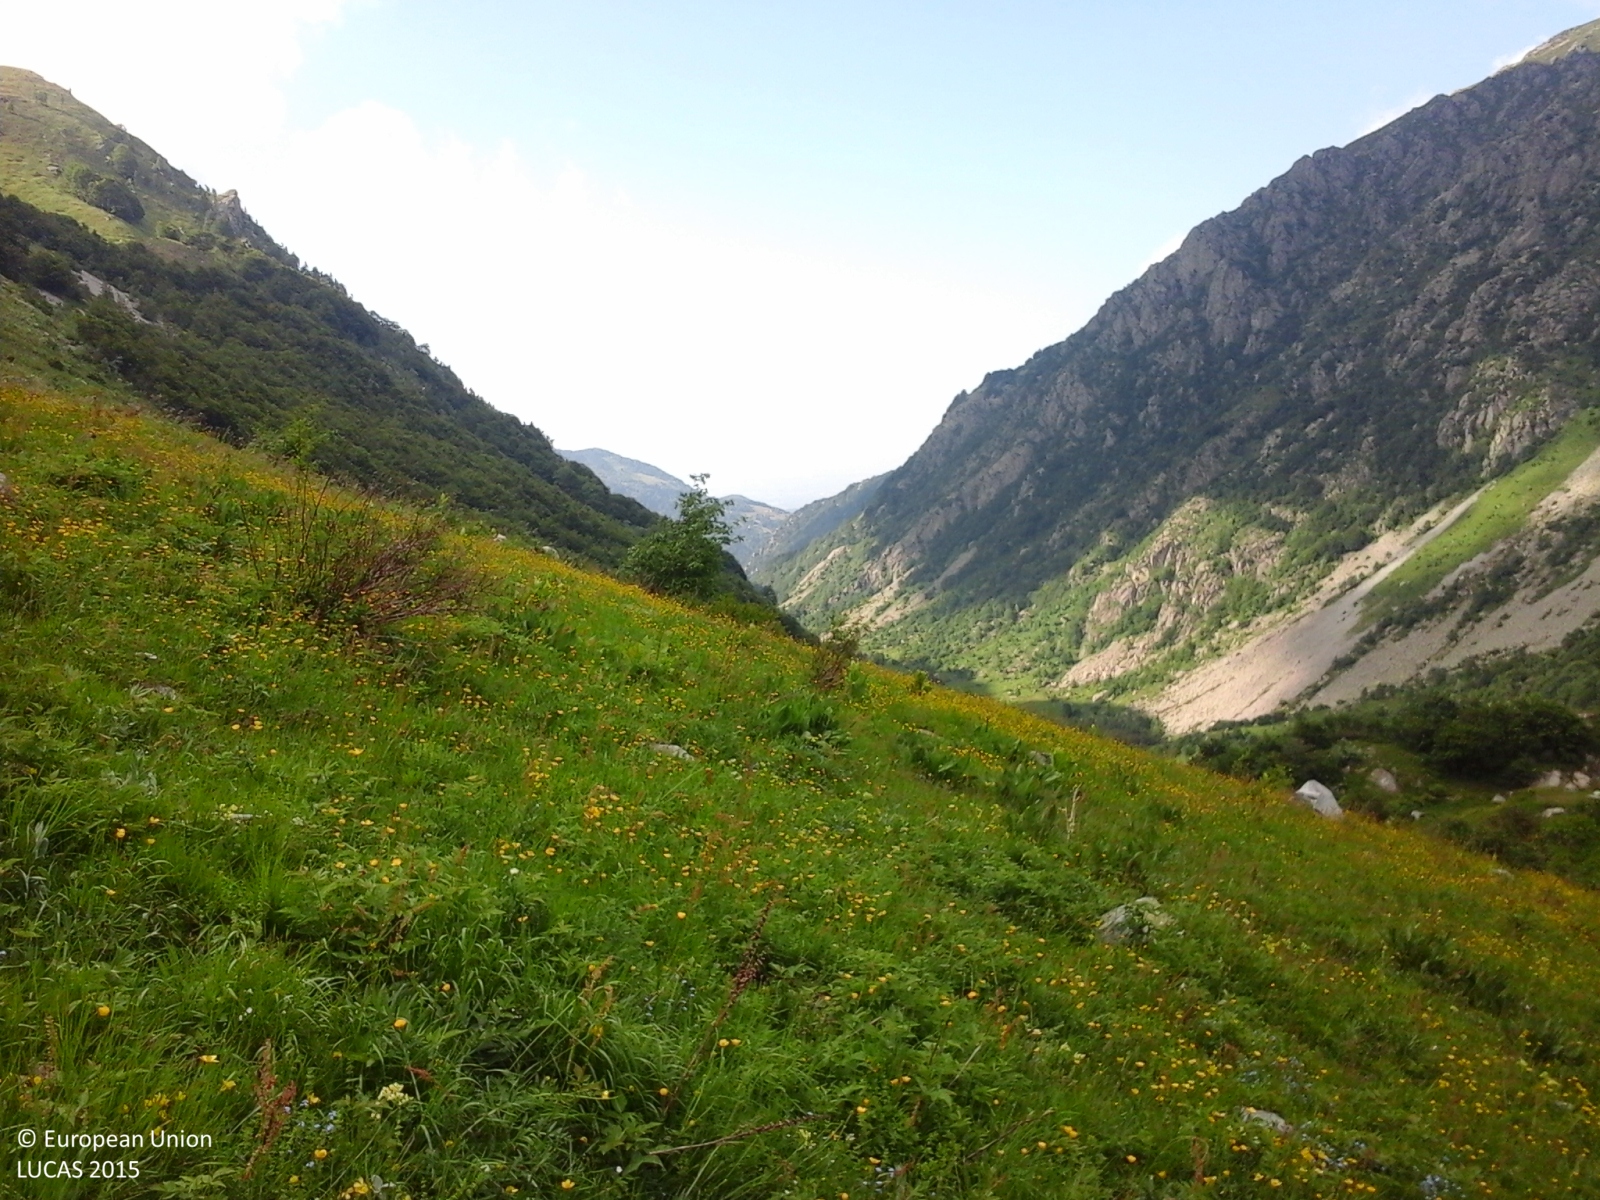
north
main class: Grassland
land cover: Grassland without tree/shrub cover
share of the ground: > 75 %
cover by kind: herbaceous plants 75 %, consolidated bare surface 15 %, shrubs 5 %, lichens and mosses 5 %
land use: Agriculture (excluding fallow land and kitchen gardens)
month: June
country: IT
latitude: 44.2171
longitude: 7.7145
